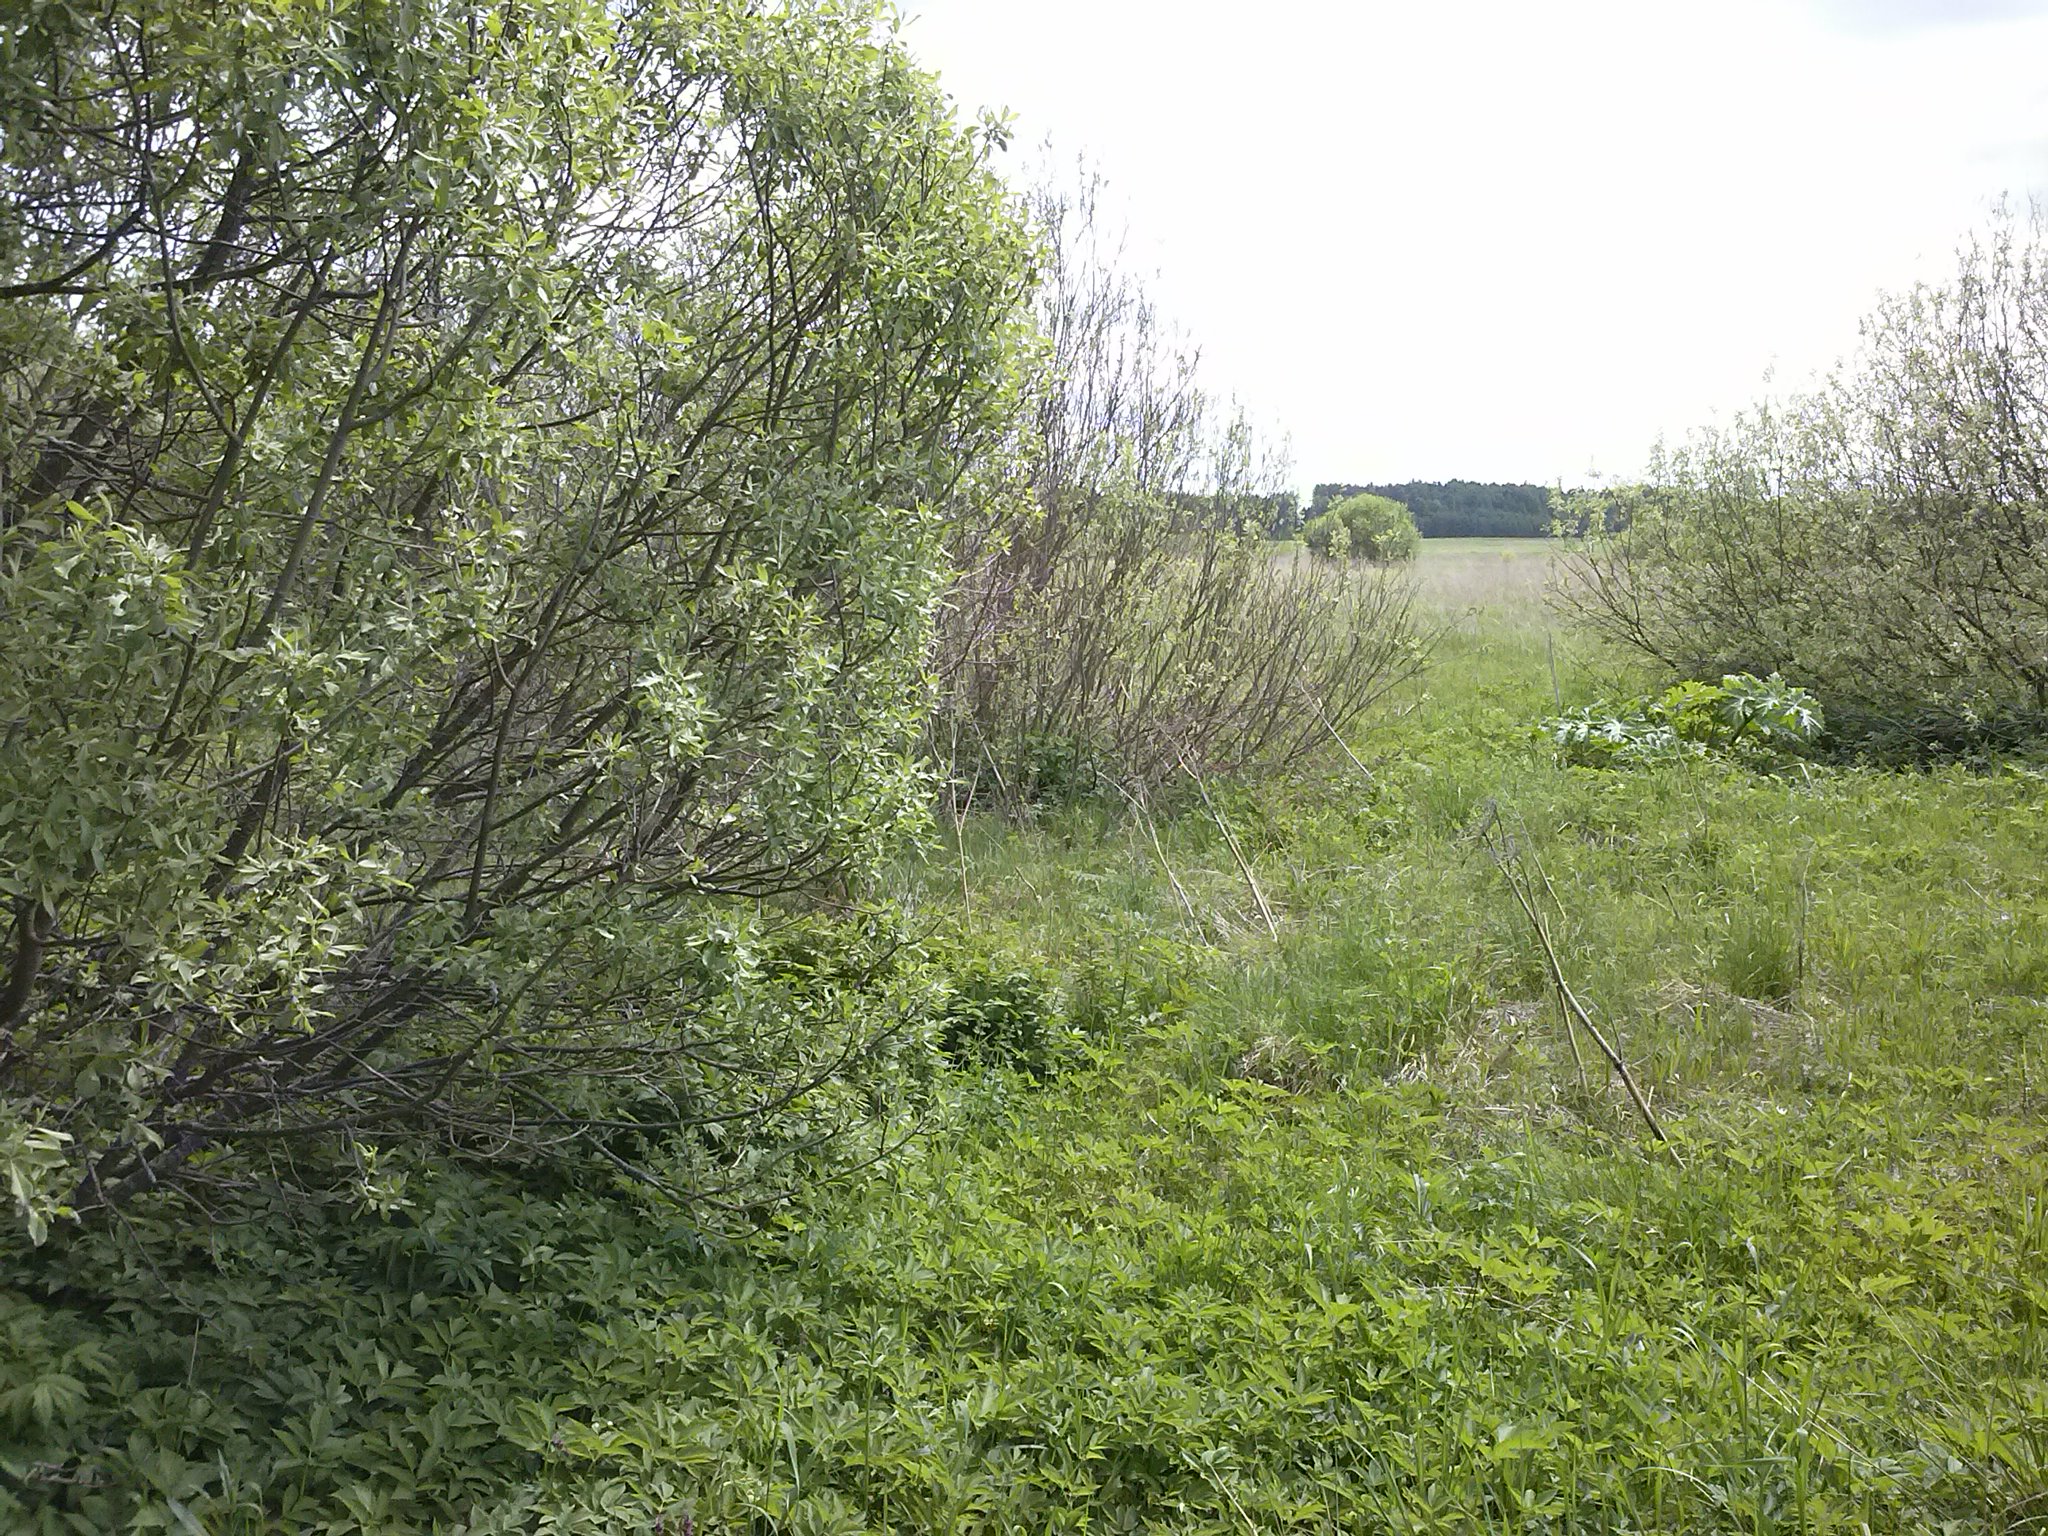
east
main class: Grassland
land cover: Grassland with sparse tree/shrub cover
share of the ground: > 75 %
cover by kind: herbaceous plants 90 %, broadleaved forest trees 5 %, shrubs 5 %
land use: Agriculture (excluding fallow land and kitchen gardens)
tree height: < 5 m
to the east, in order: Grassland with sparse tree/shrub cover; Grassland without tree/shrub cover; Grassland with sparse tree/shrub cover; Grassland without tree/shrub cover; Rape and turnip rape
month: May
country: LV
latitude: 56.1706
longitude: 27.7612
